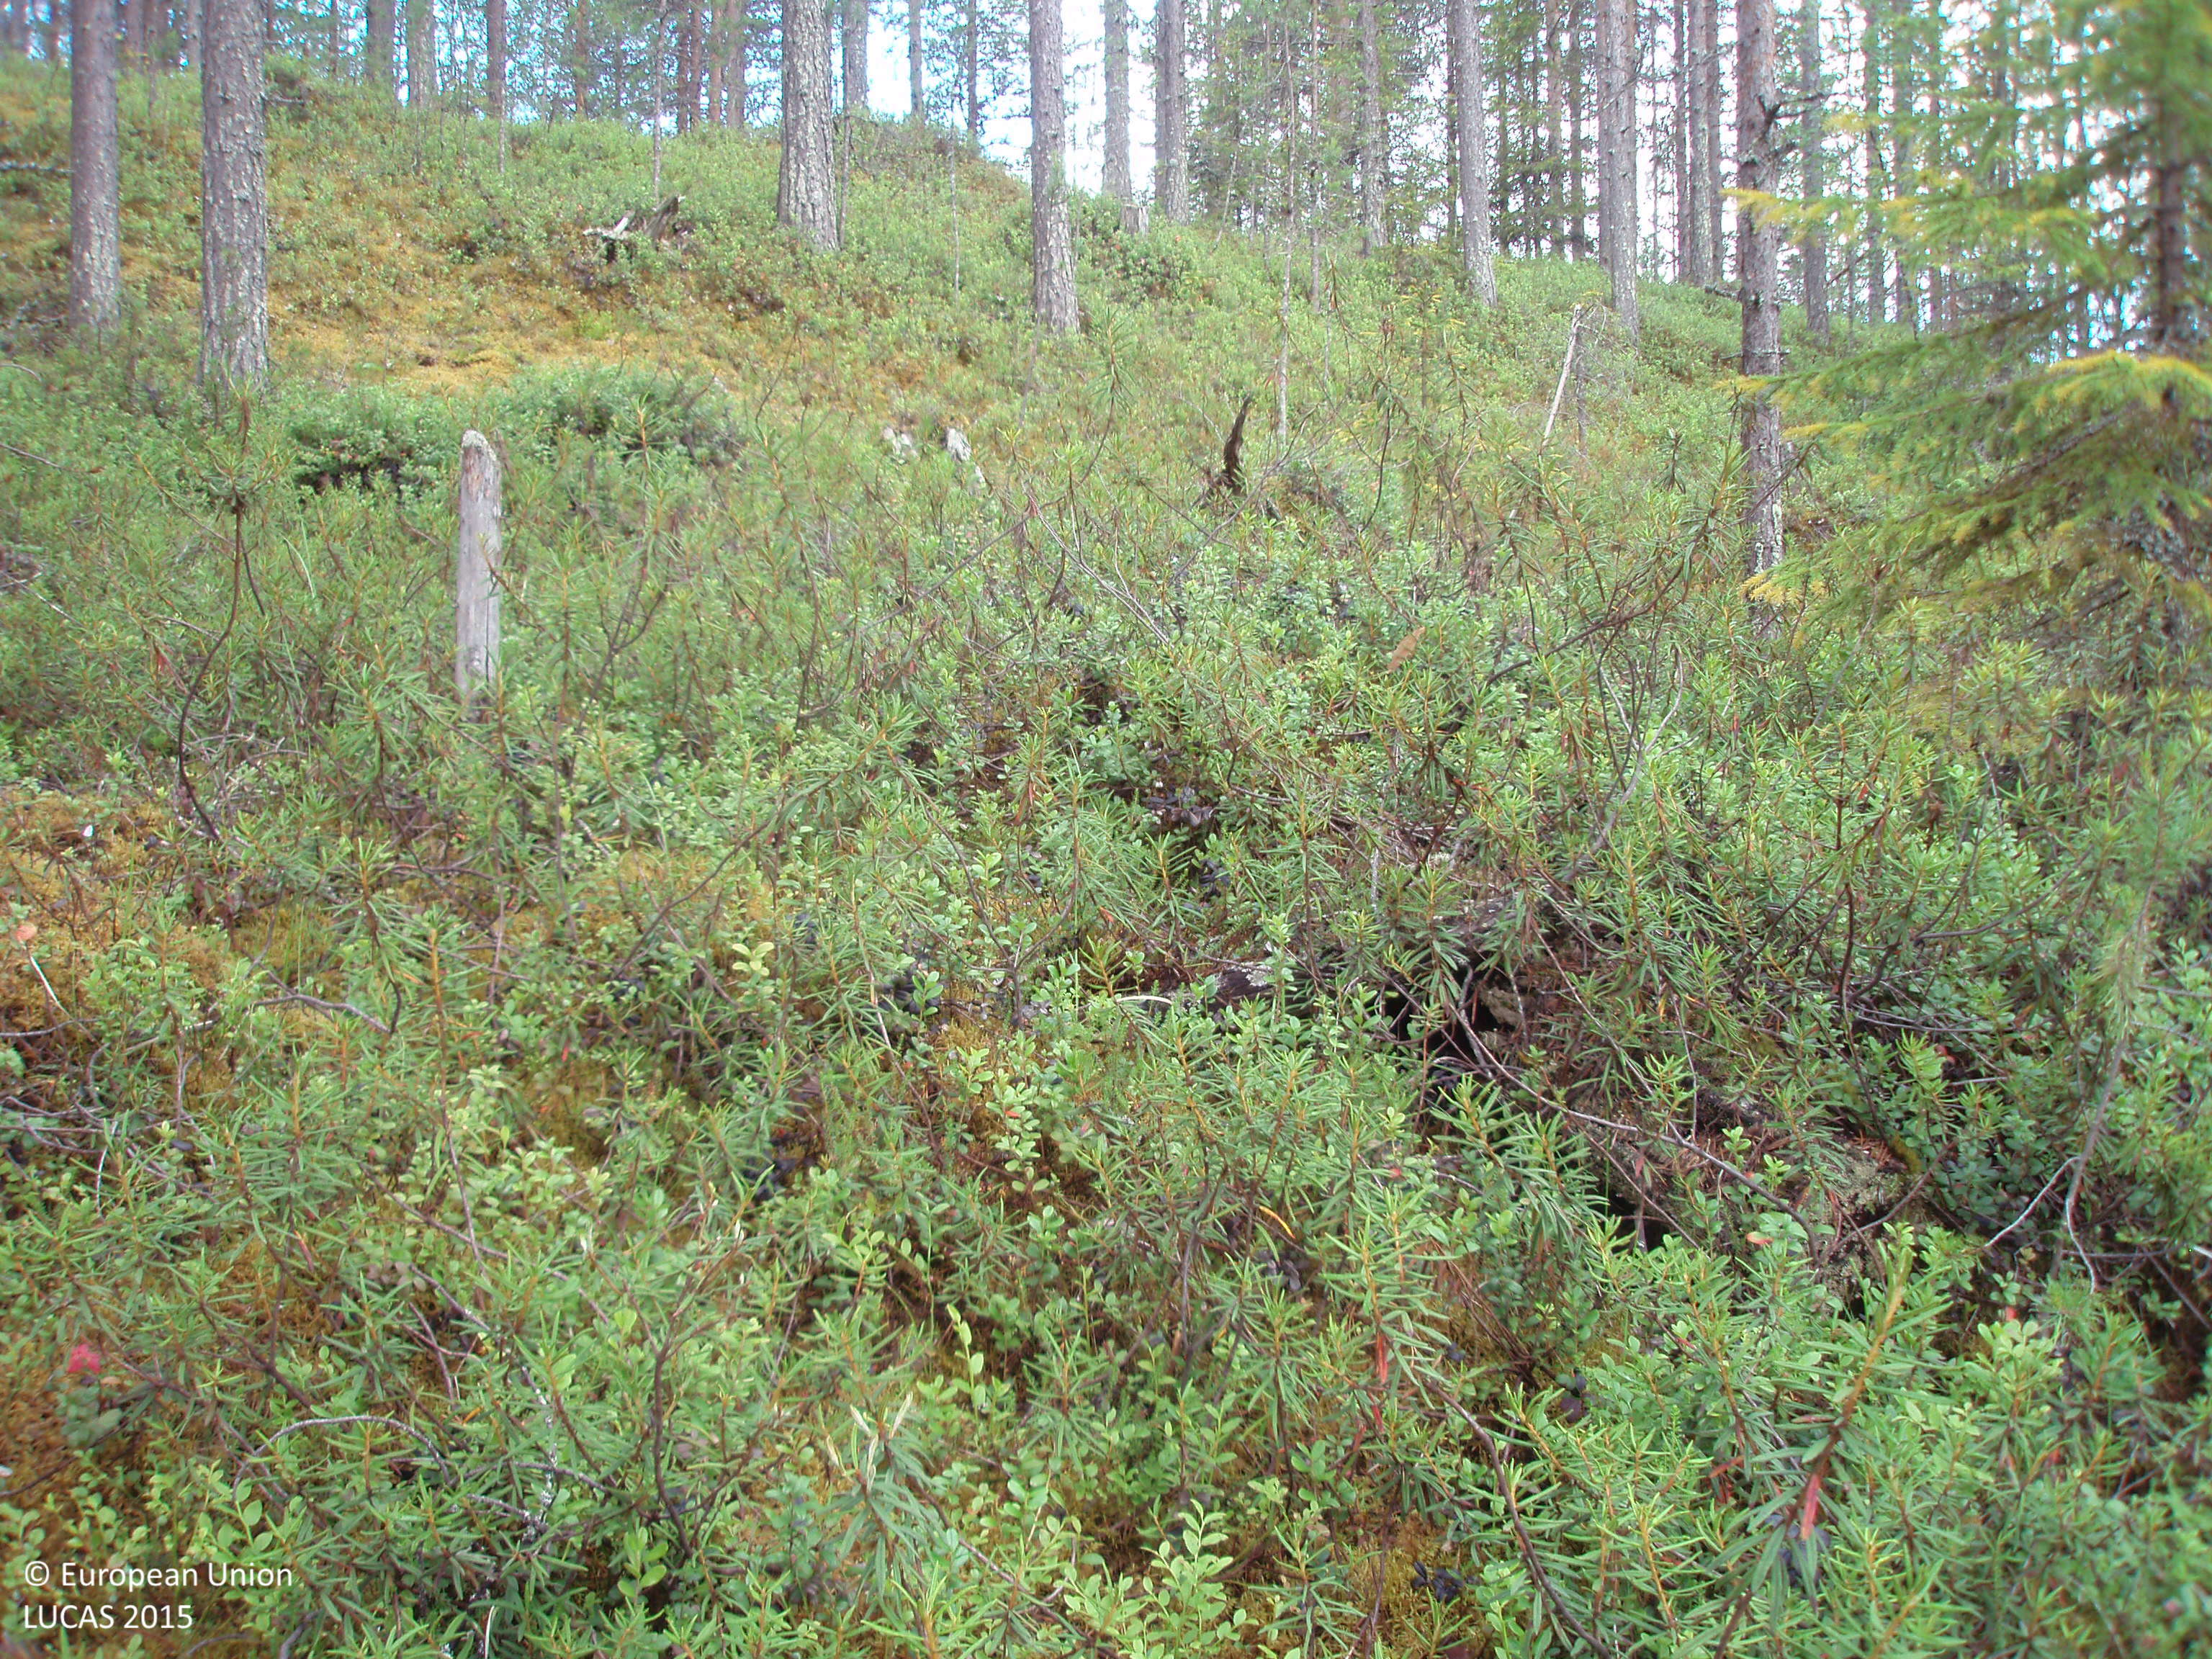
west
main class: Woodland
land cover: Pine dominated coniferous woodland
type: boreal forest
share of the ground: 50 - 75 %
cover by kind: coniferous forest trees 70 %, shrubs 30 %
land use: Forestry
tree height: > 5 m
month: July
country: FI
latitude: 66.9555
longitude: 27.8595
